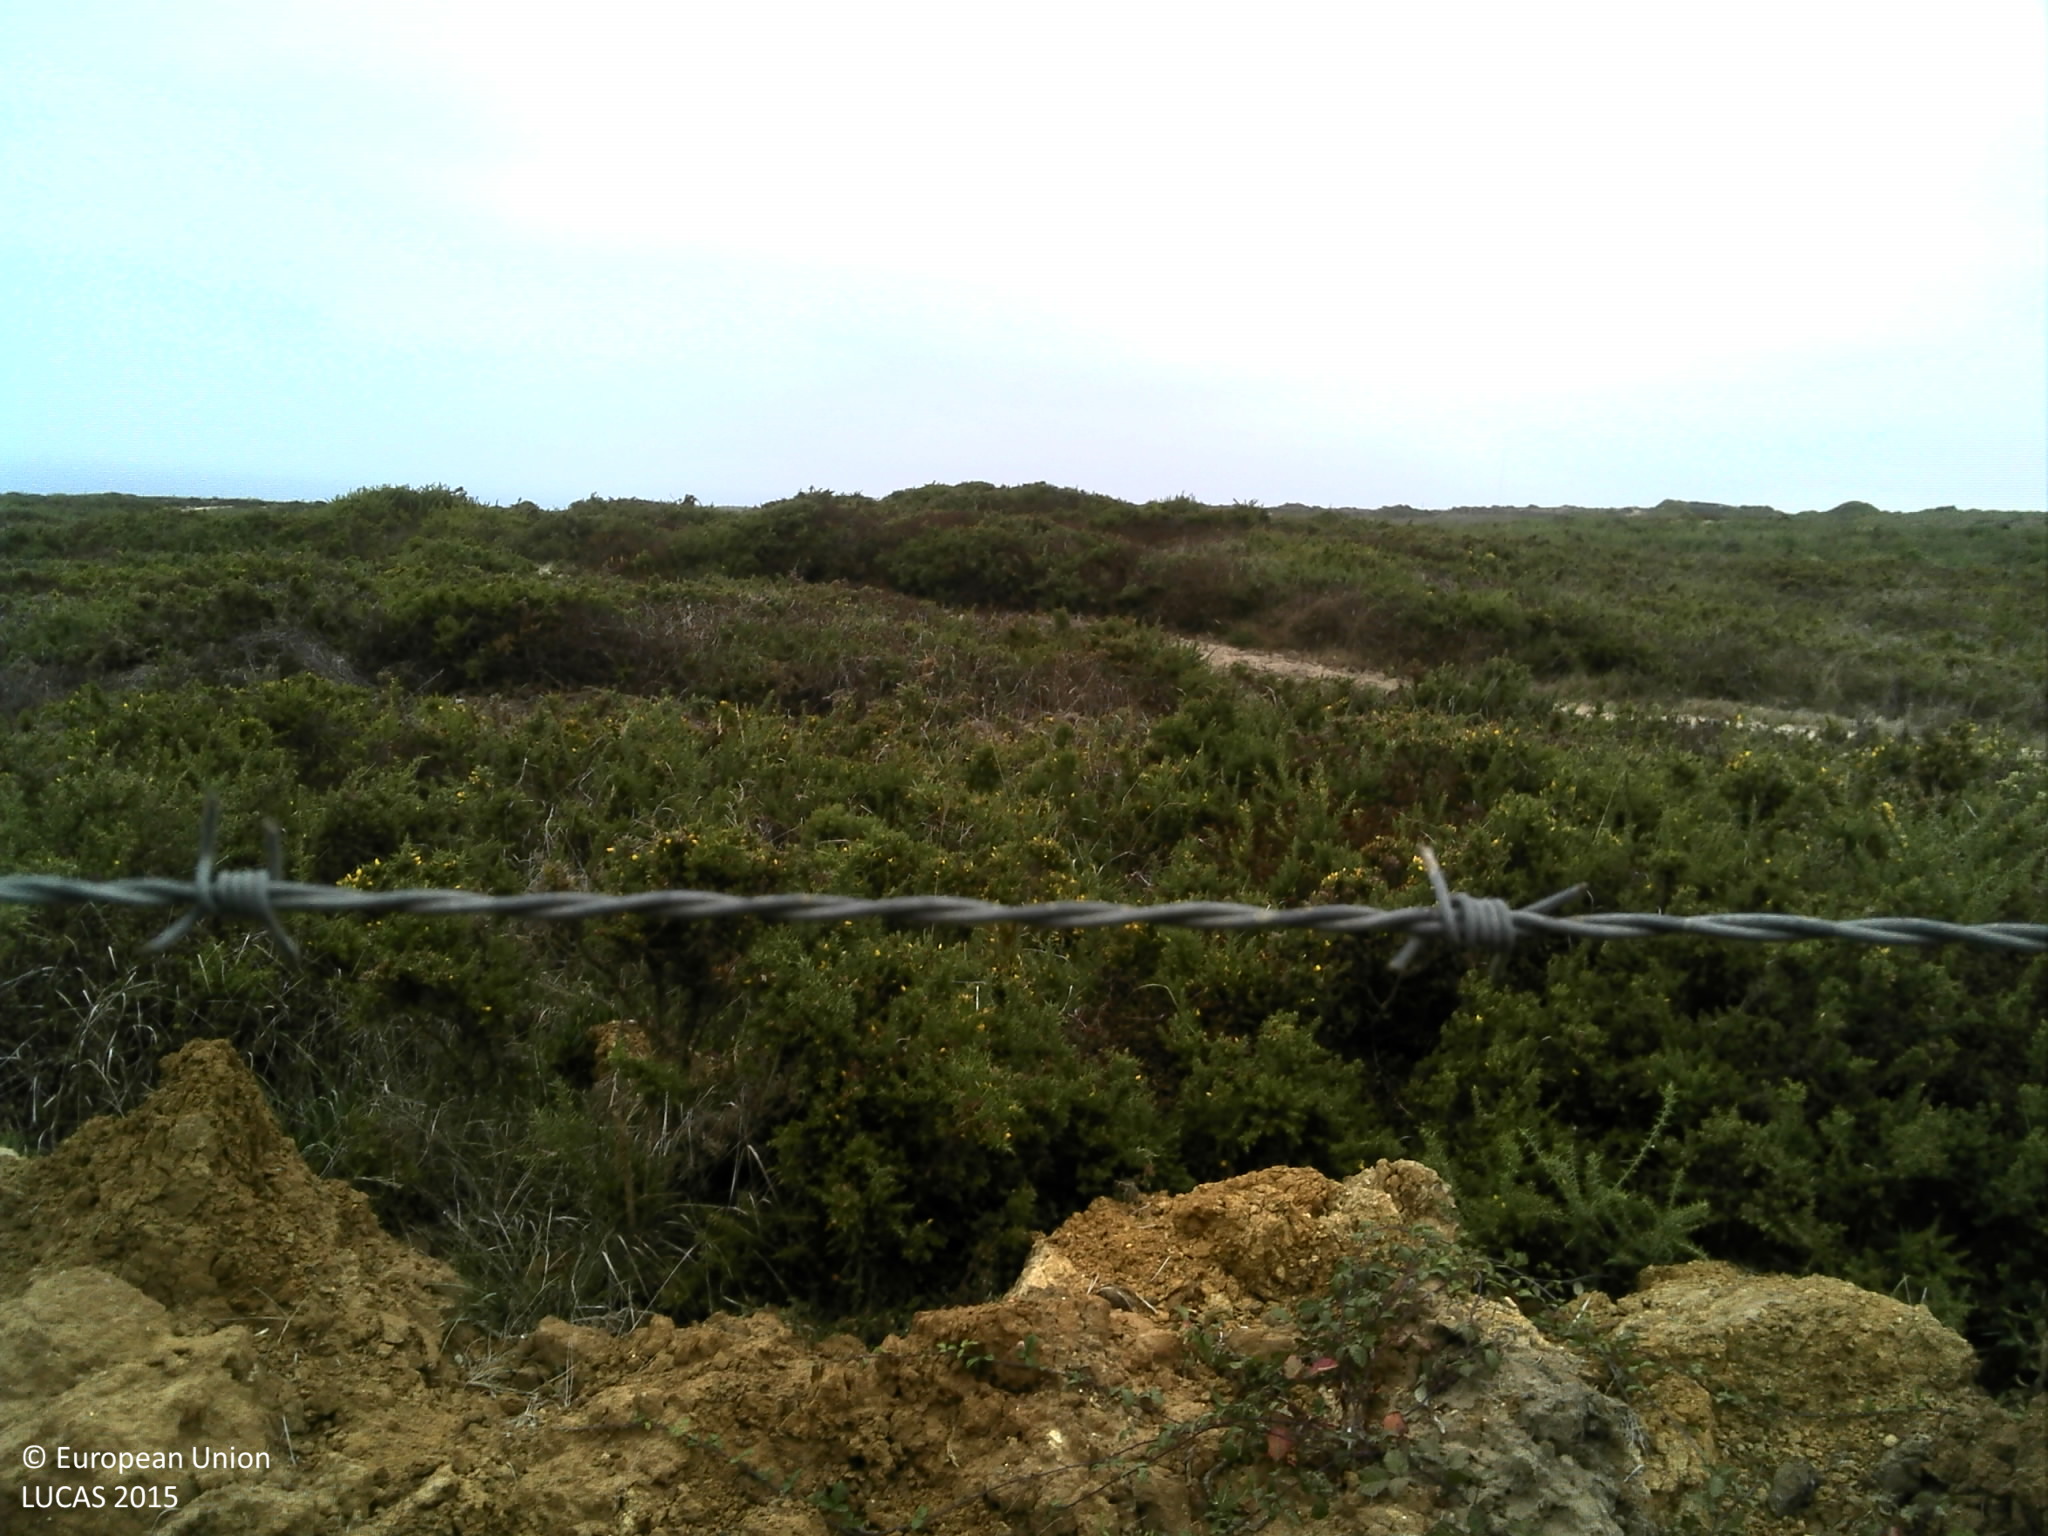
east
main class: Shrubland
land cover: Shrubland without tree cover
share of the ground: > 75 %
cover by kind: shrubs 90 %, unconsolidated bare surface 10 %
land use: Semi-natural and natural areas not in use
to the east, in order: Shrubland without tree cover; Tracks; Shrubland without tree cover
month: August
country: PT
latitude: 38.8764
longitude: -9.4405
